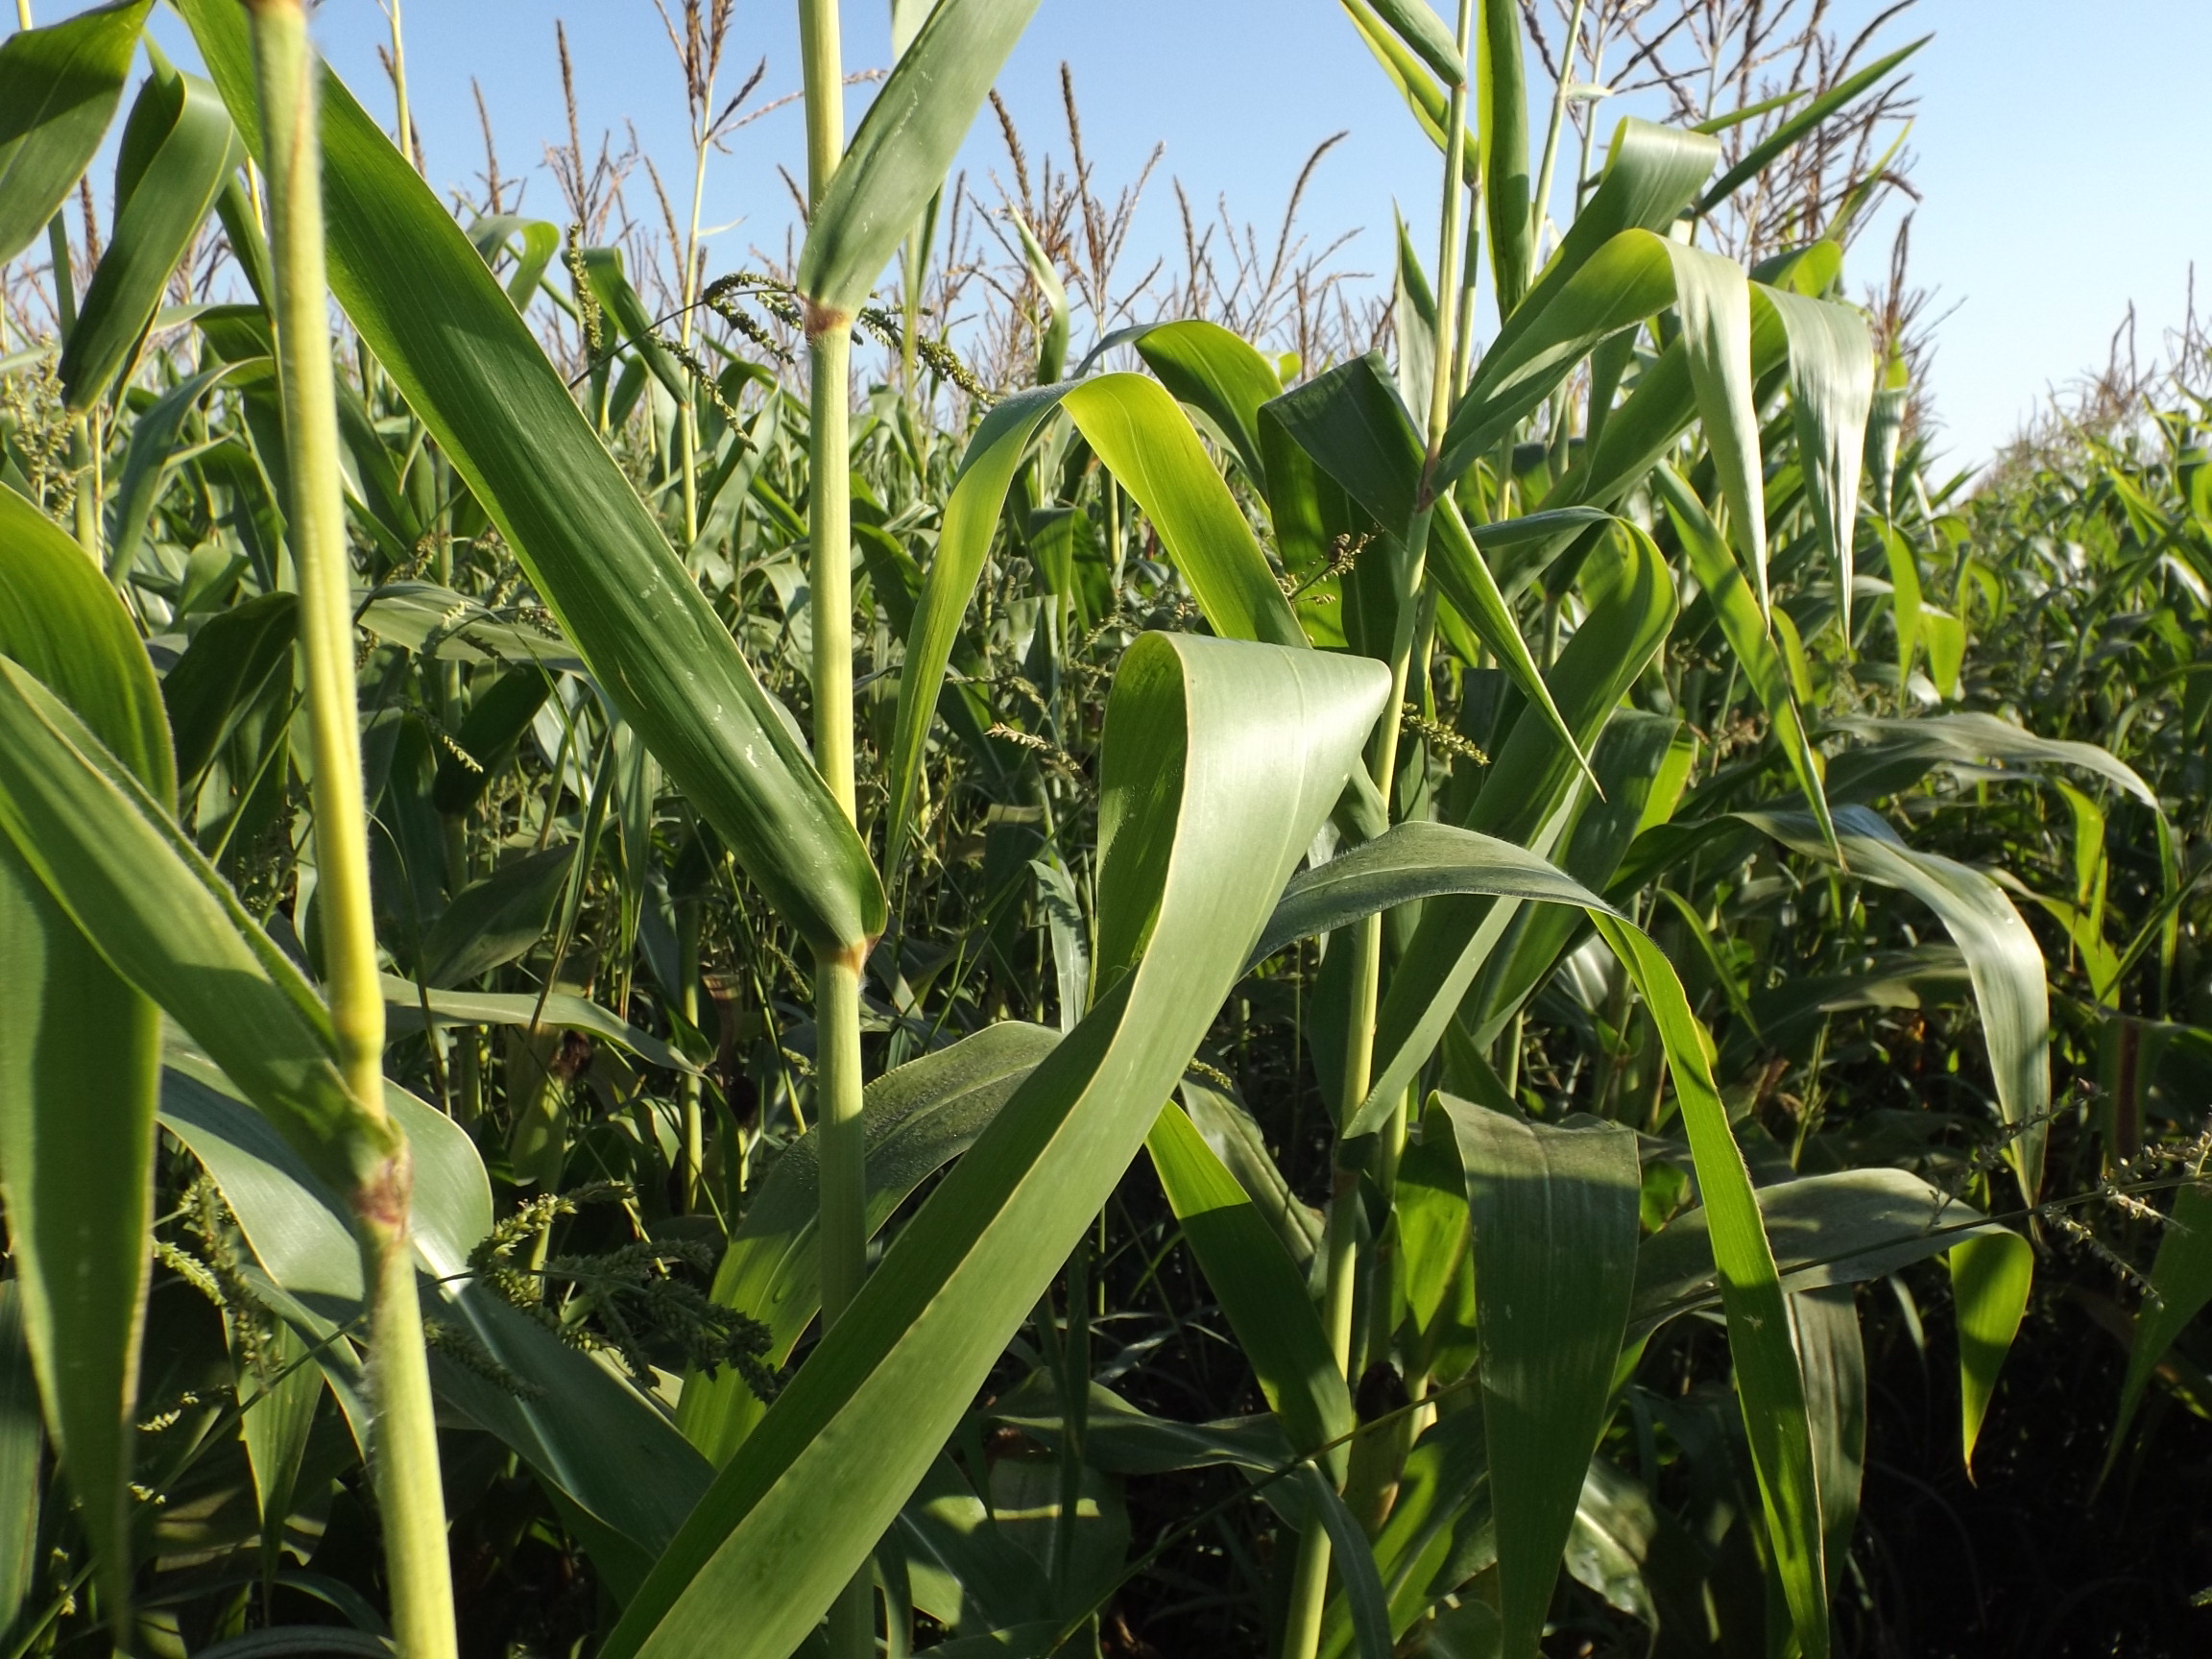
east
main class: Cropland
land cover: Maize
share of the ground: > 75 %
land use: Agriculture (excluding fallow land and kitchen gardens)
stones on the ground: < 10 %
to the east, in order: Maize
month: August
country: BG
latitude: 43.3209
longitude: 27.9605
